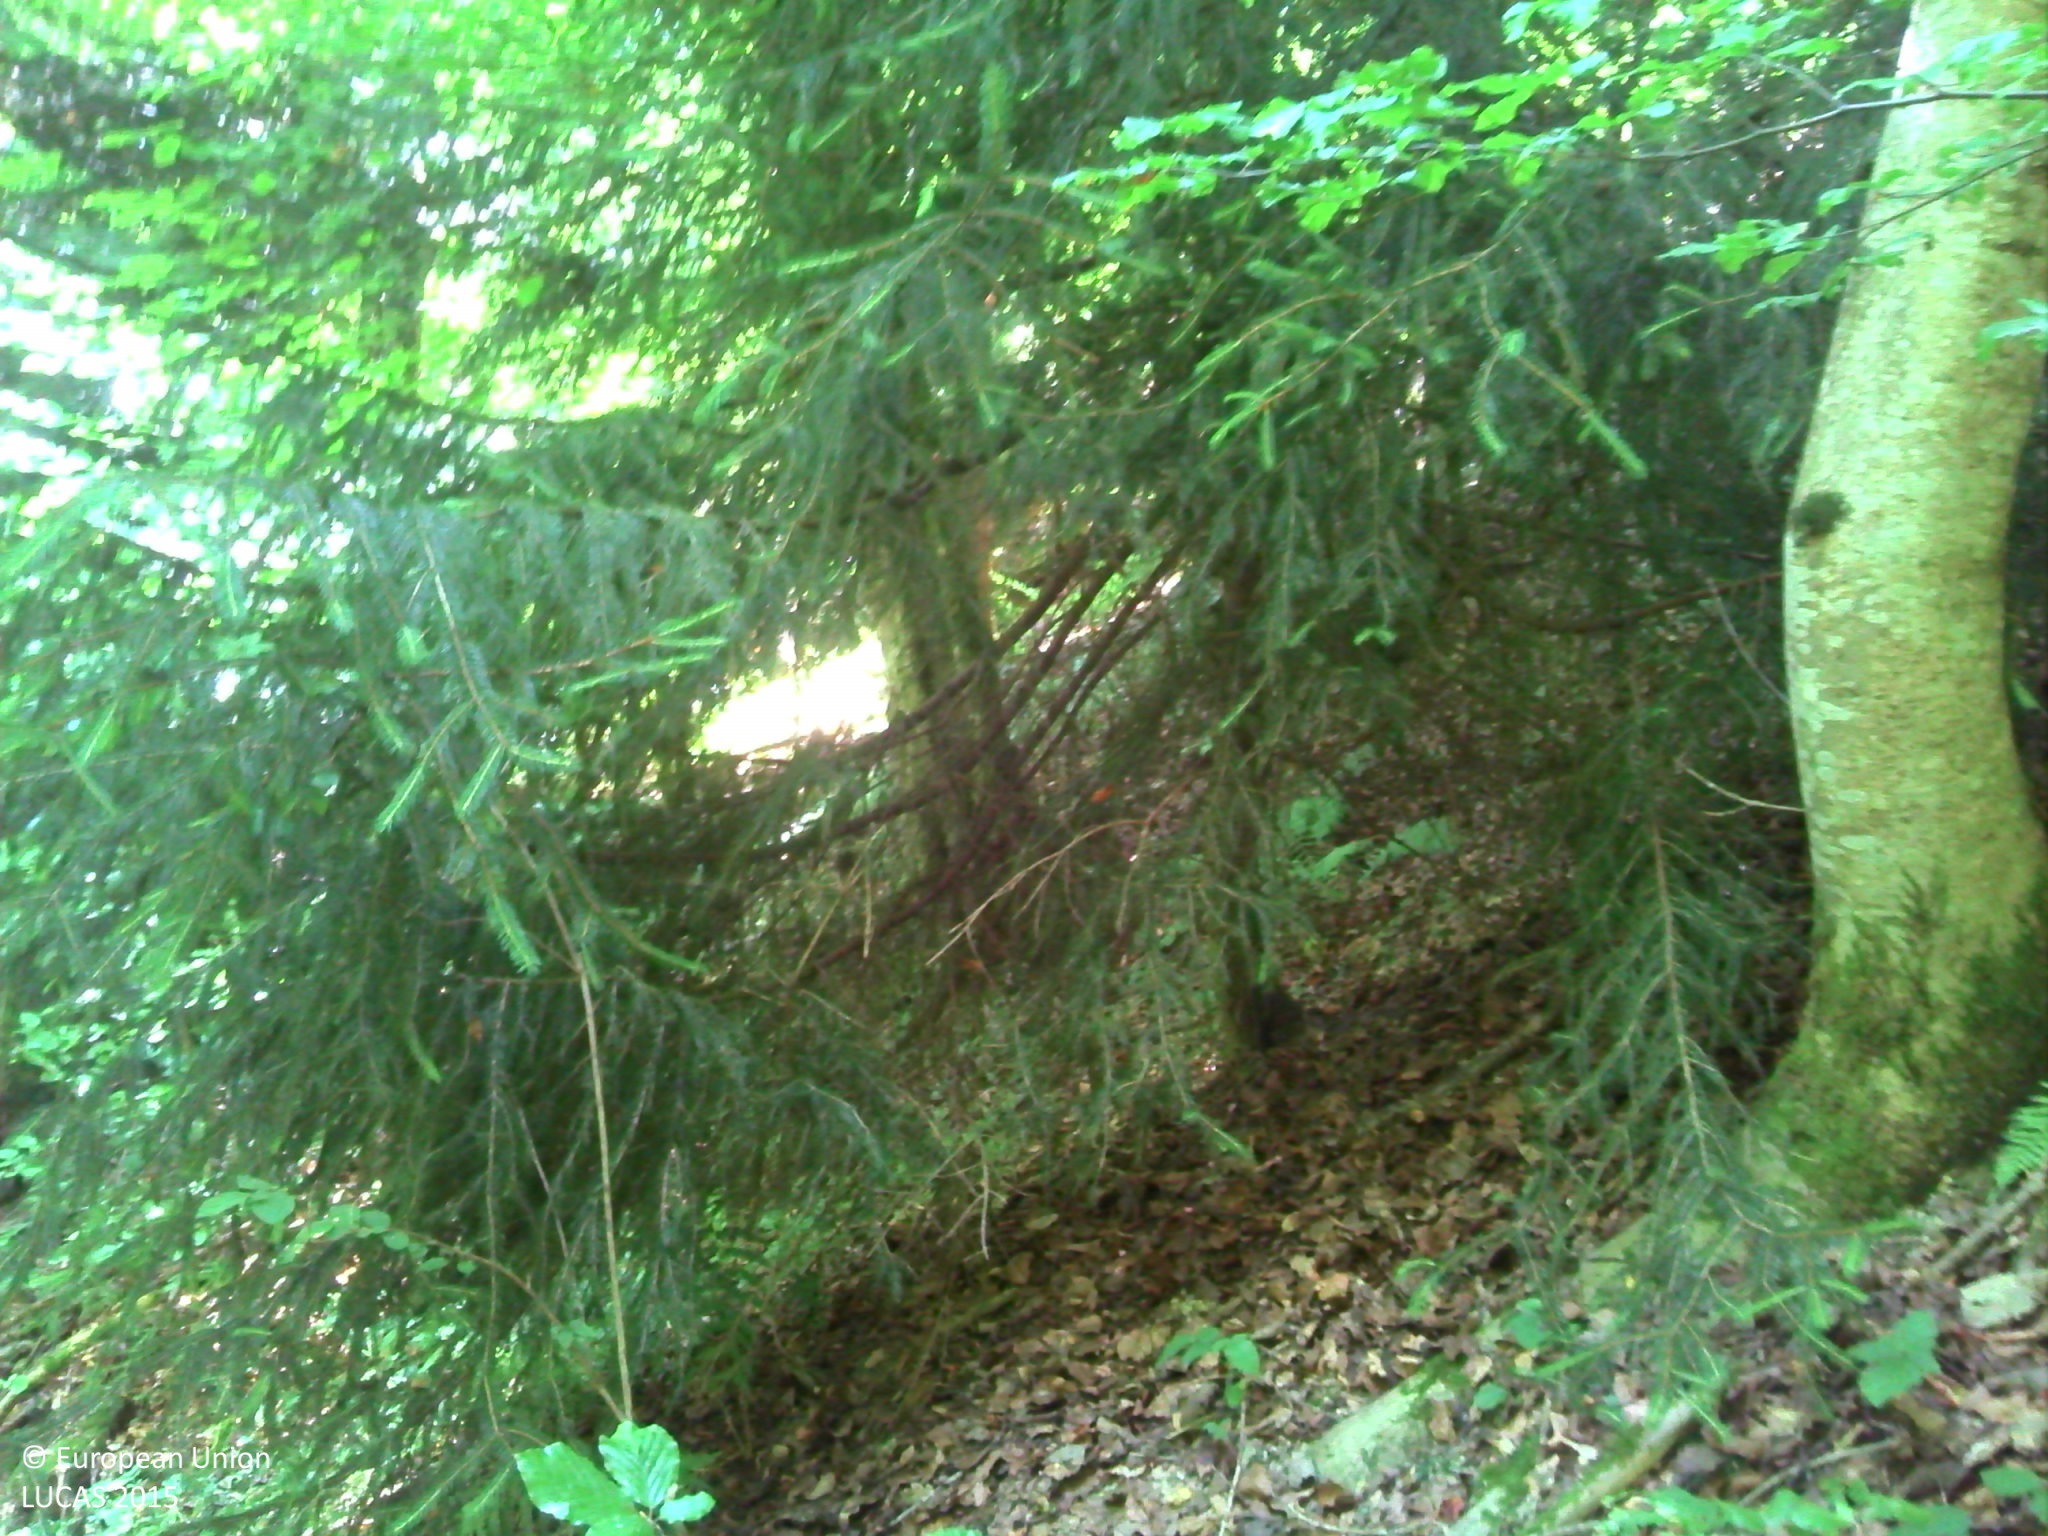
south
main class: Woodland
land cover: Spruce dominated mixed woodland
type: mountainous beech forest
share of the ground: > 75 %
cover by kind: broadleaved forest trees 40 %, coniferous forest trees 35 %, herbaceous plants 20 %, lichens and mosses 5 %
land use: Forestry
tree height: > 5 m
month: July
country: FR
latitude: 45.8871
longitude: 6.2026
